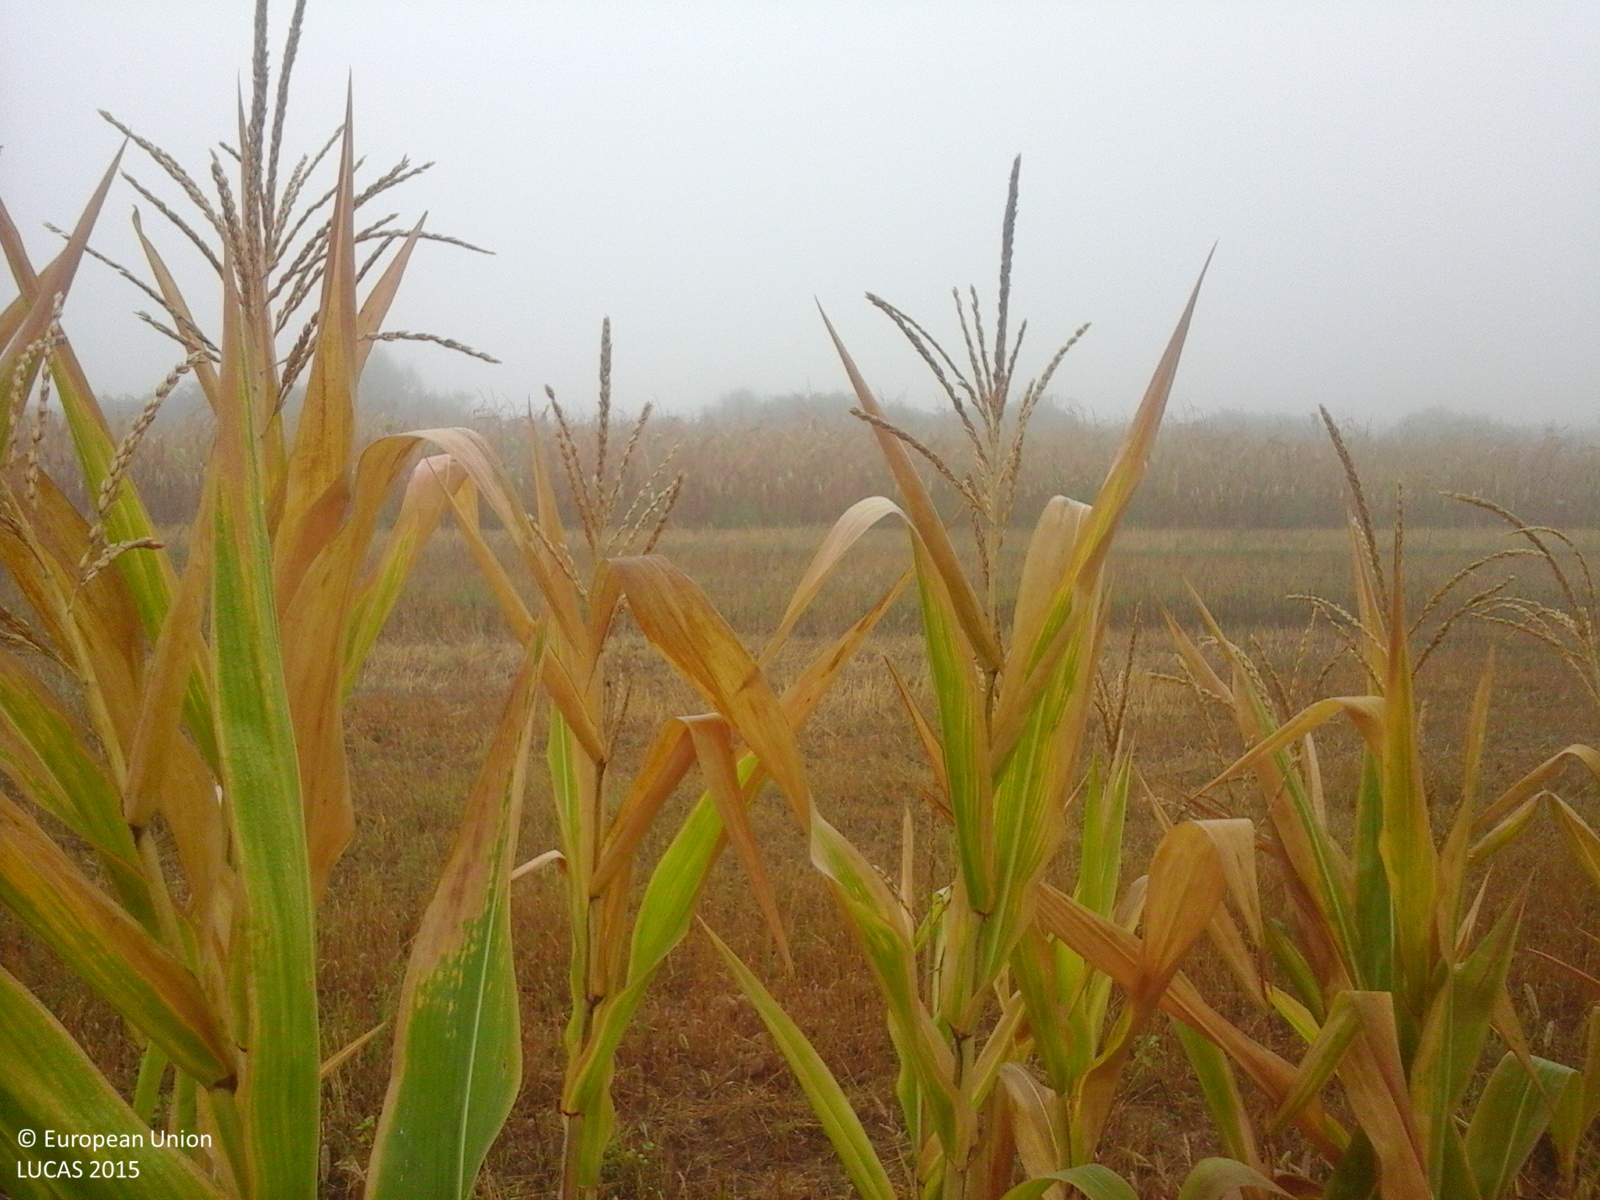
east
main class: Cropland
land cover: Maize
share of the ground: > 75 %
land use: Agriculture (excluding fallow land and kitchen gardens)
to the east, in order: Maize; Common wheat; Maize; Potatoes; Maize; Tracks; Shrubland without tree cover; Tracks; Ditches and canals; Shrubland without tree cover; Maize; Sunflower
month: September
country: RO
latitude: 47.9996
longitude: 22.9739
